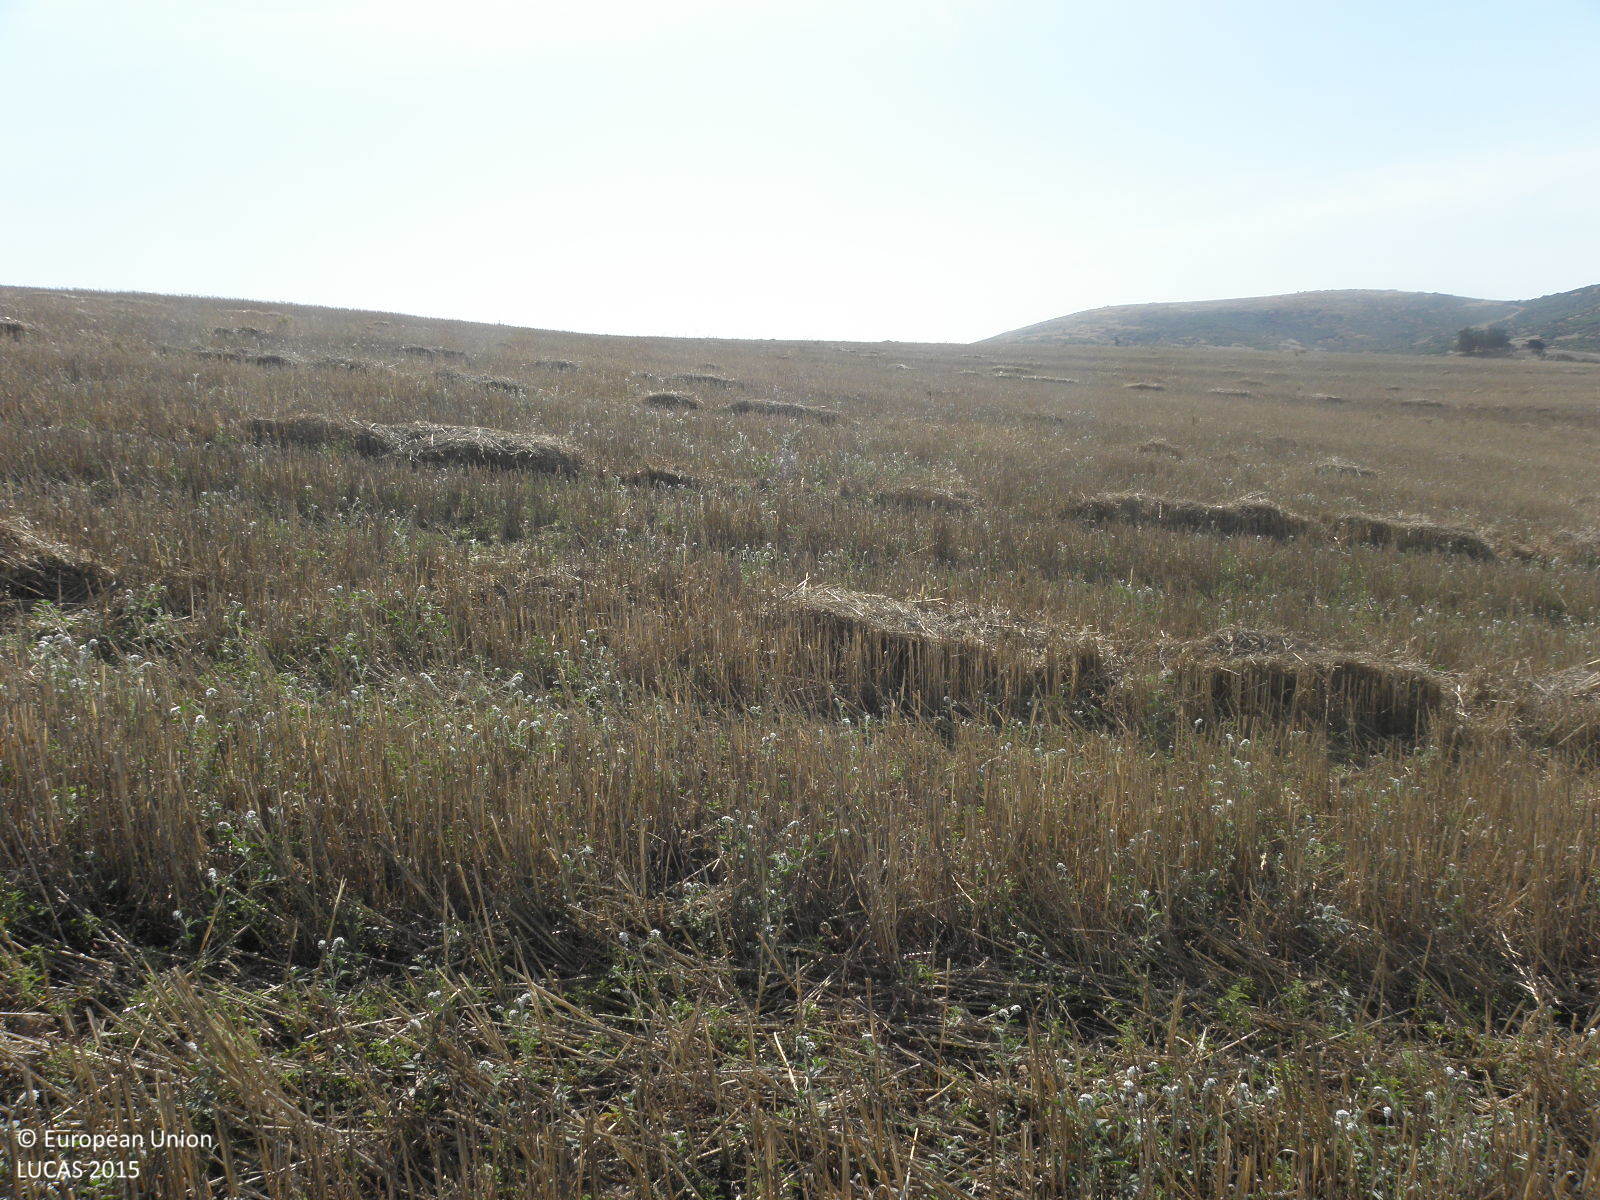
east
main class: Cropland
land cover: Durum wheat
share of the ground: > 75 %
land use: Agriculture (excluding fallow land and kitchen gardens)
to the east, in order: Durum wheat; Shruby margins; Tracks; Grassland without tree/shrub cover; Other coniferous woodland; Electric lines; Other coniferous woodland
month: July
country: GR
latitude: 39.4366
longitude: 22.2901
